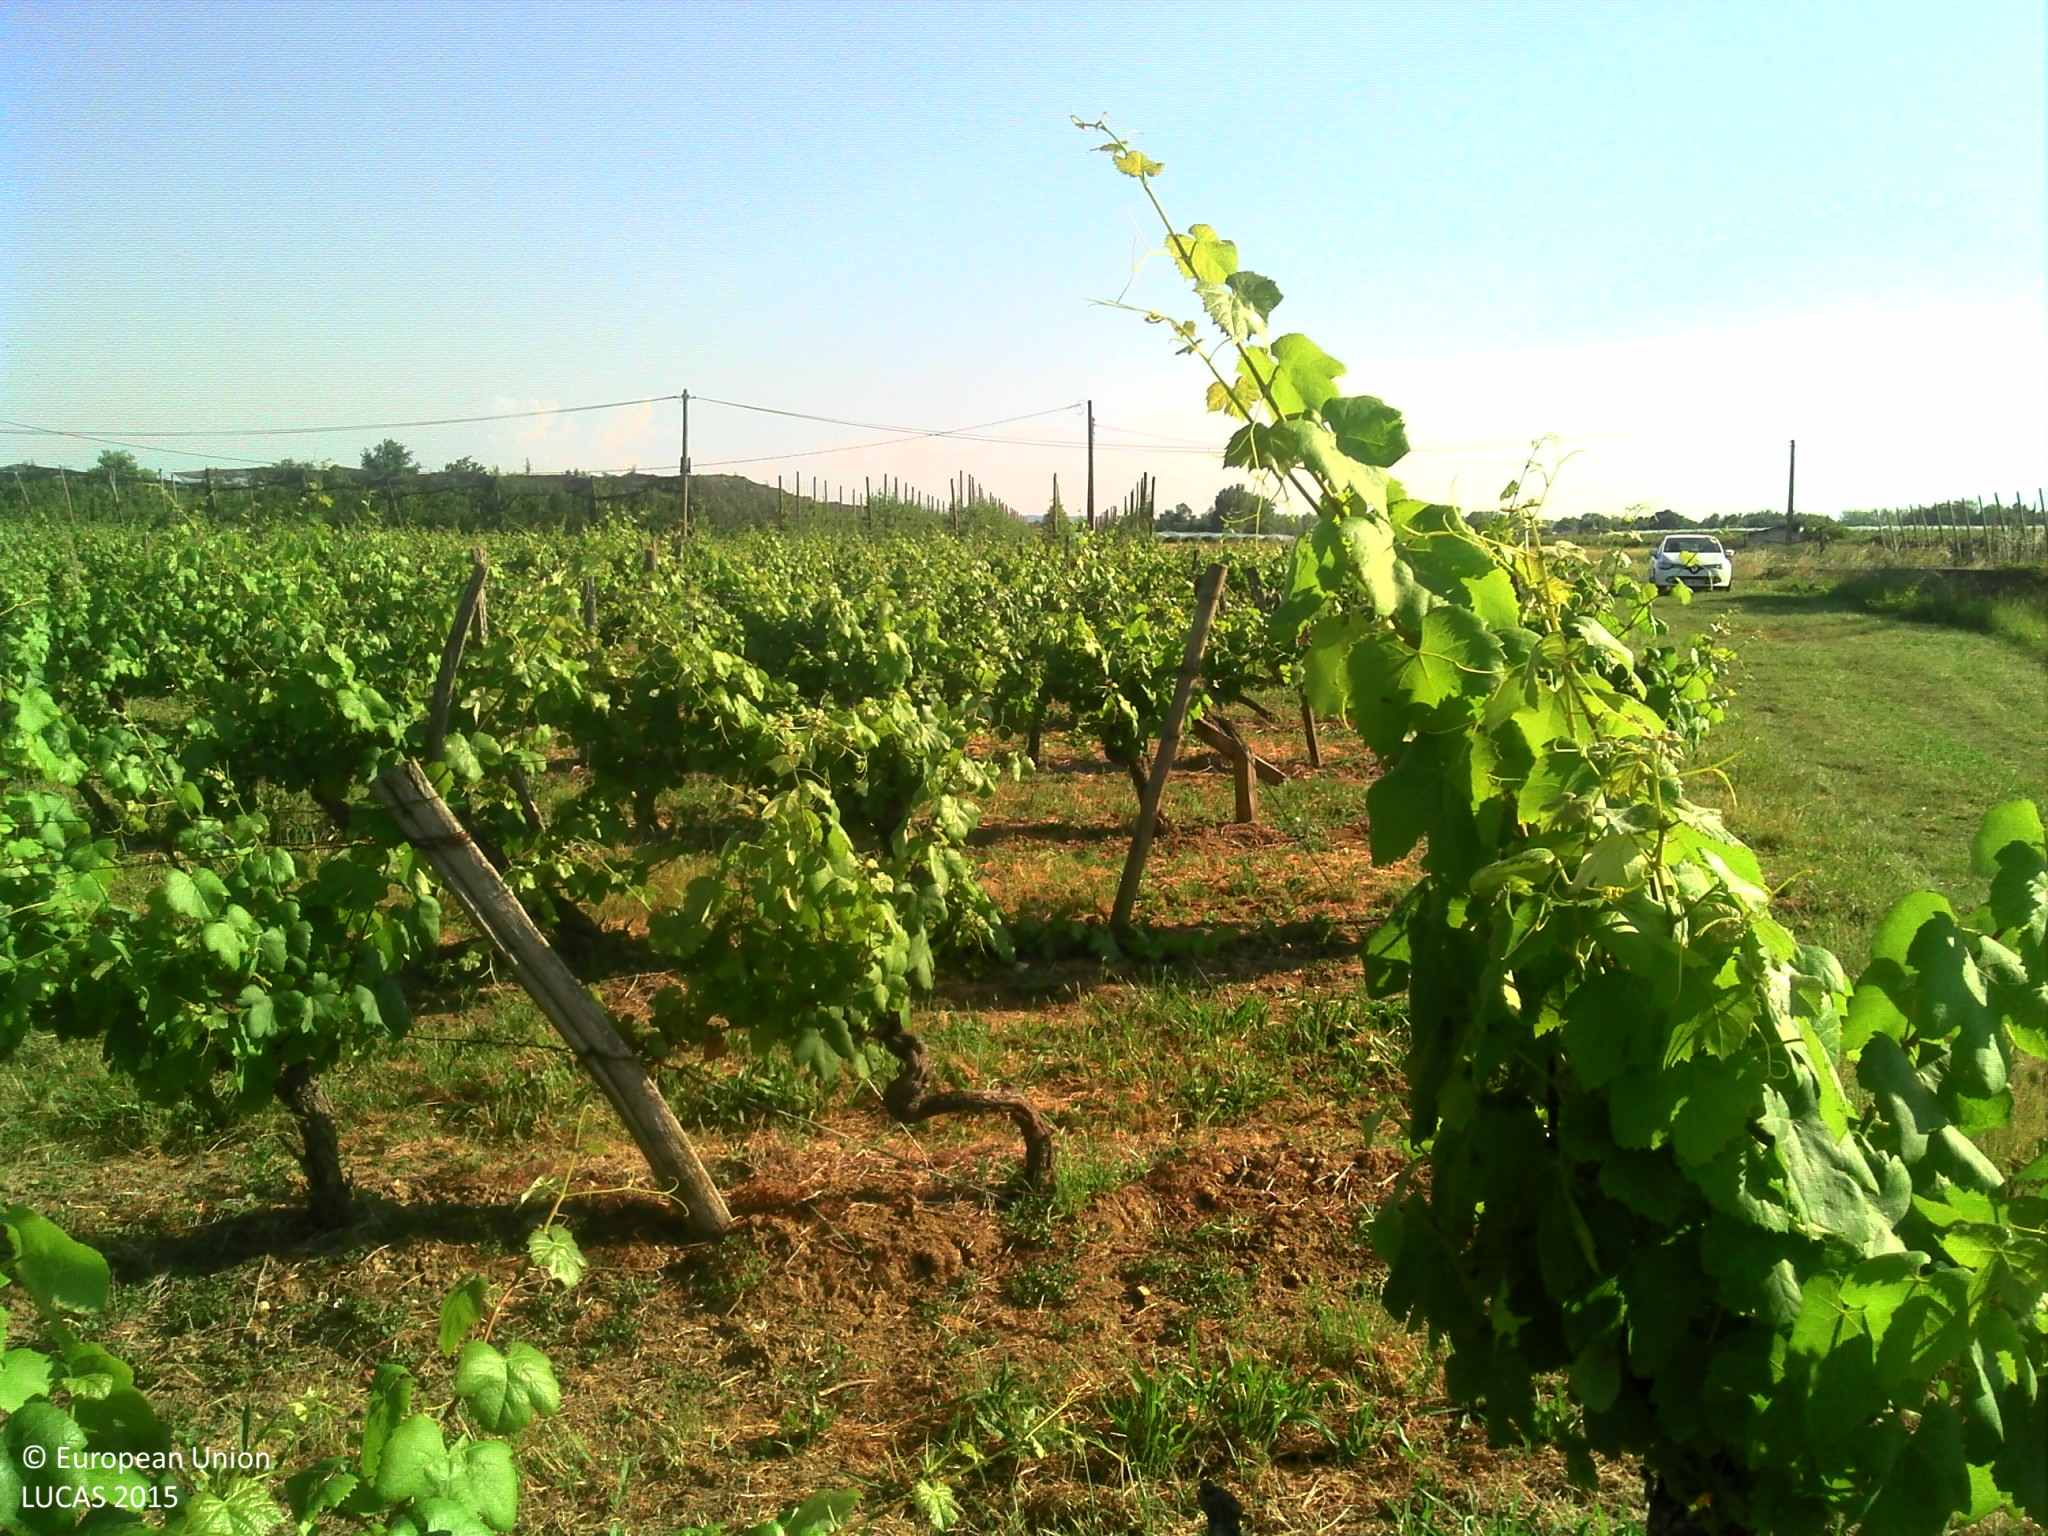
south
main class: Cropland
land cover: Vineyards
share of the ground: 10 - 25 %
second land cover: Spontaneously vegetated surfaces
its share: 25 - 50 %
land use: Agriculture (excluding fallow land and kitchen gardens)
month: June
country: FR
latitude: 43.9283
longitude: 1.9441
